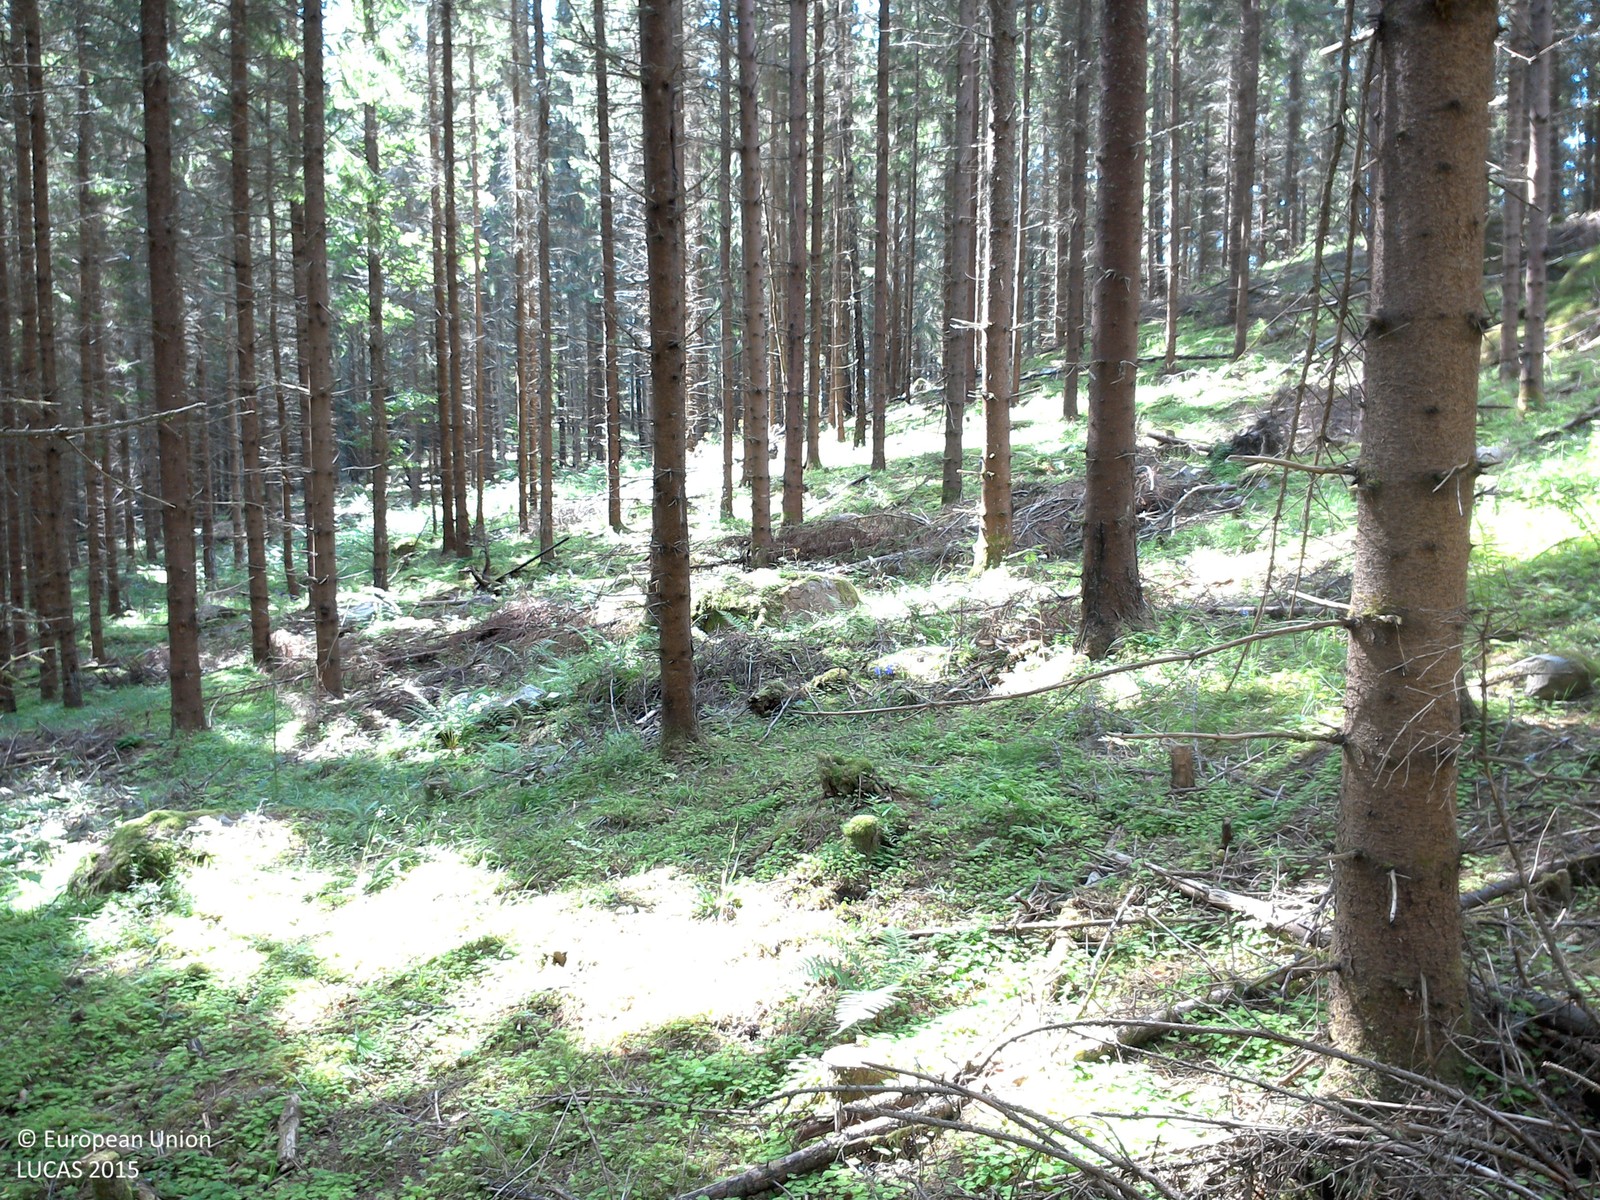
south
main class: Woodland
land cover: Spruce dominated coniferous woodland
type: boreal forest
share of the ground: 50 - 75 %
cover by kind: coniferous forest trees 60 %, herbaceous plants 20 %, lichens and mosses 20 %
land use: Forestry
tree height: > 5 m
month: July
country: SE
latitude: 58.0095
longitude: 14.7503
